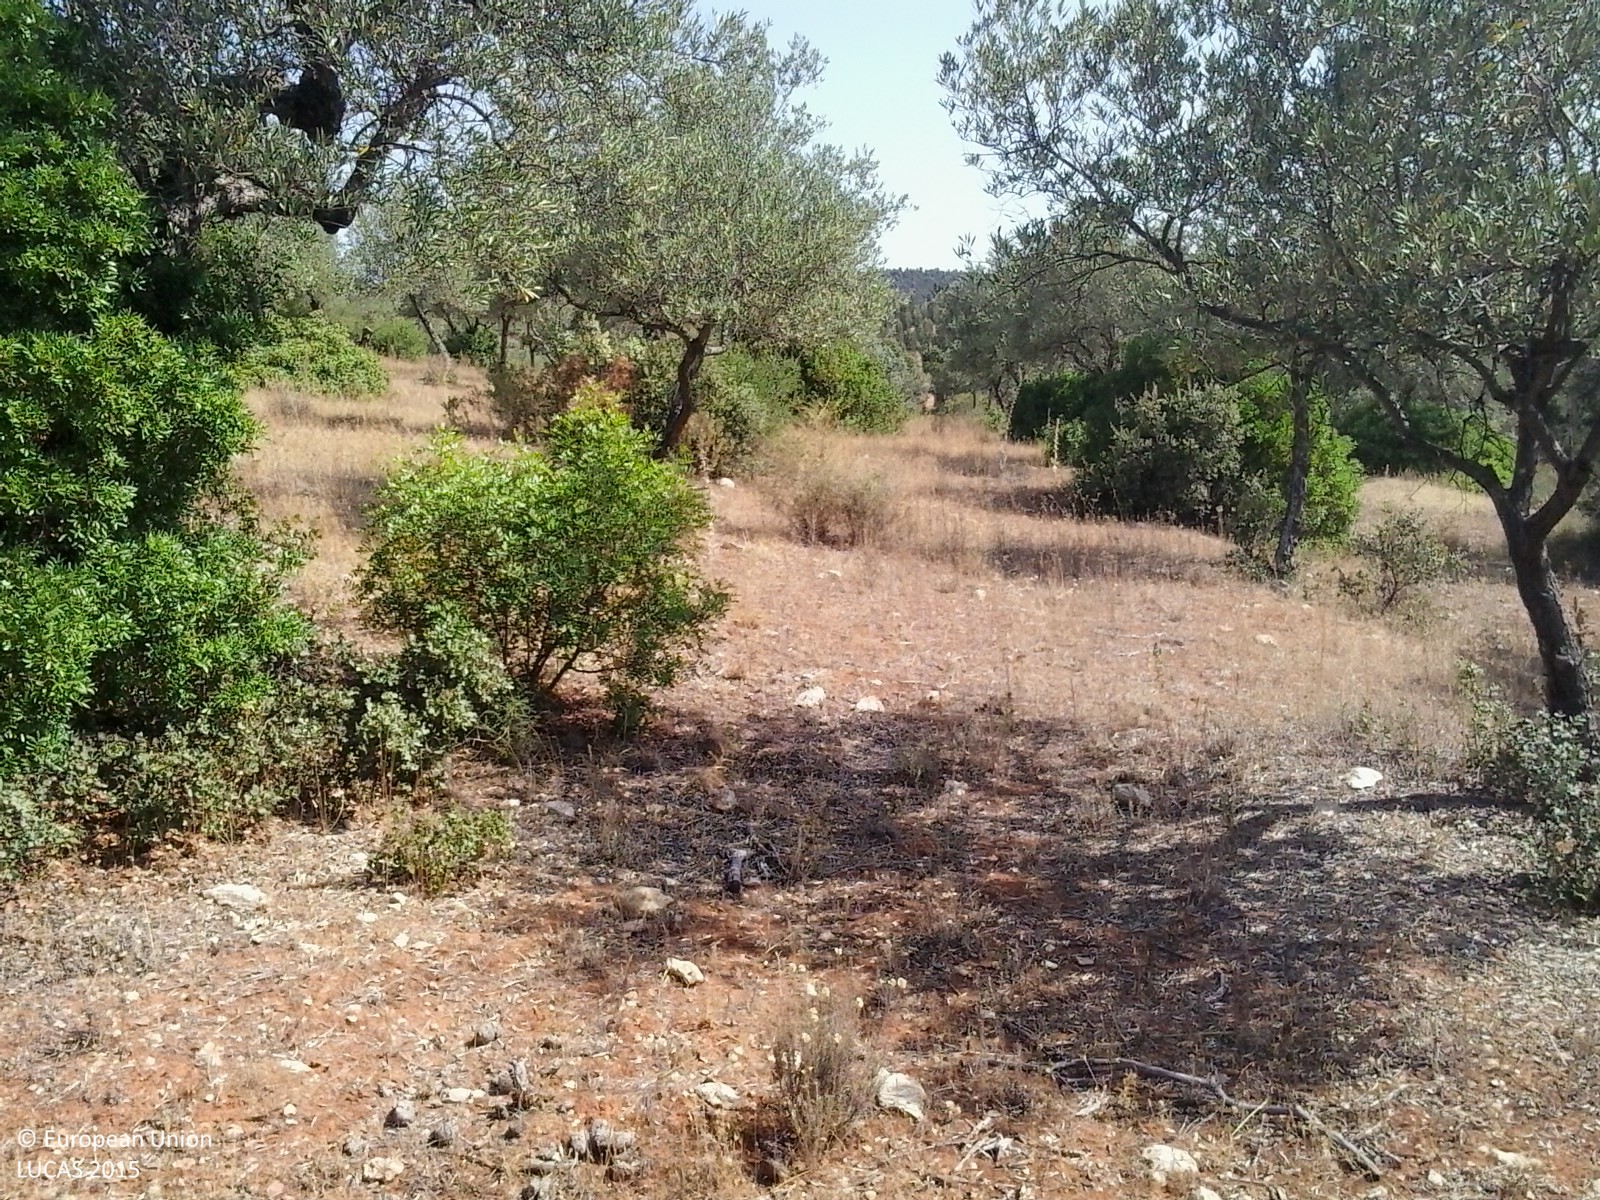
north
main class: Cropland
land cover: Olive groves
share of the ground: 25 - 50 %
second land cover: Spontaneously vegetated surfaces
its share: 50 - 75 %
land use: Agriculture (excluding fallow land and kitchen gardens)
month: July
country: ES
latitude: 37.4788
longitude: -6.4876
